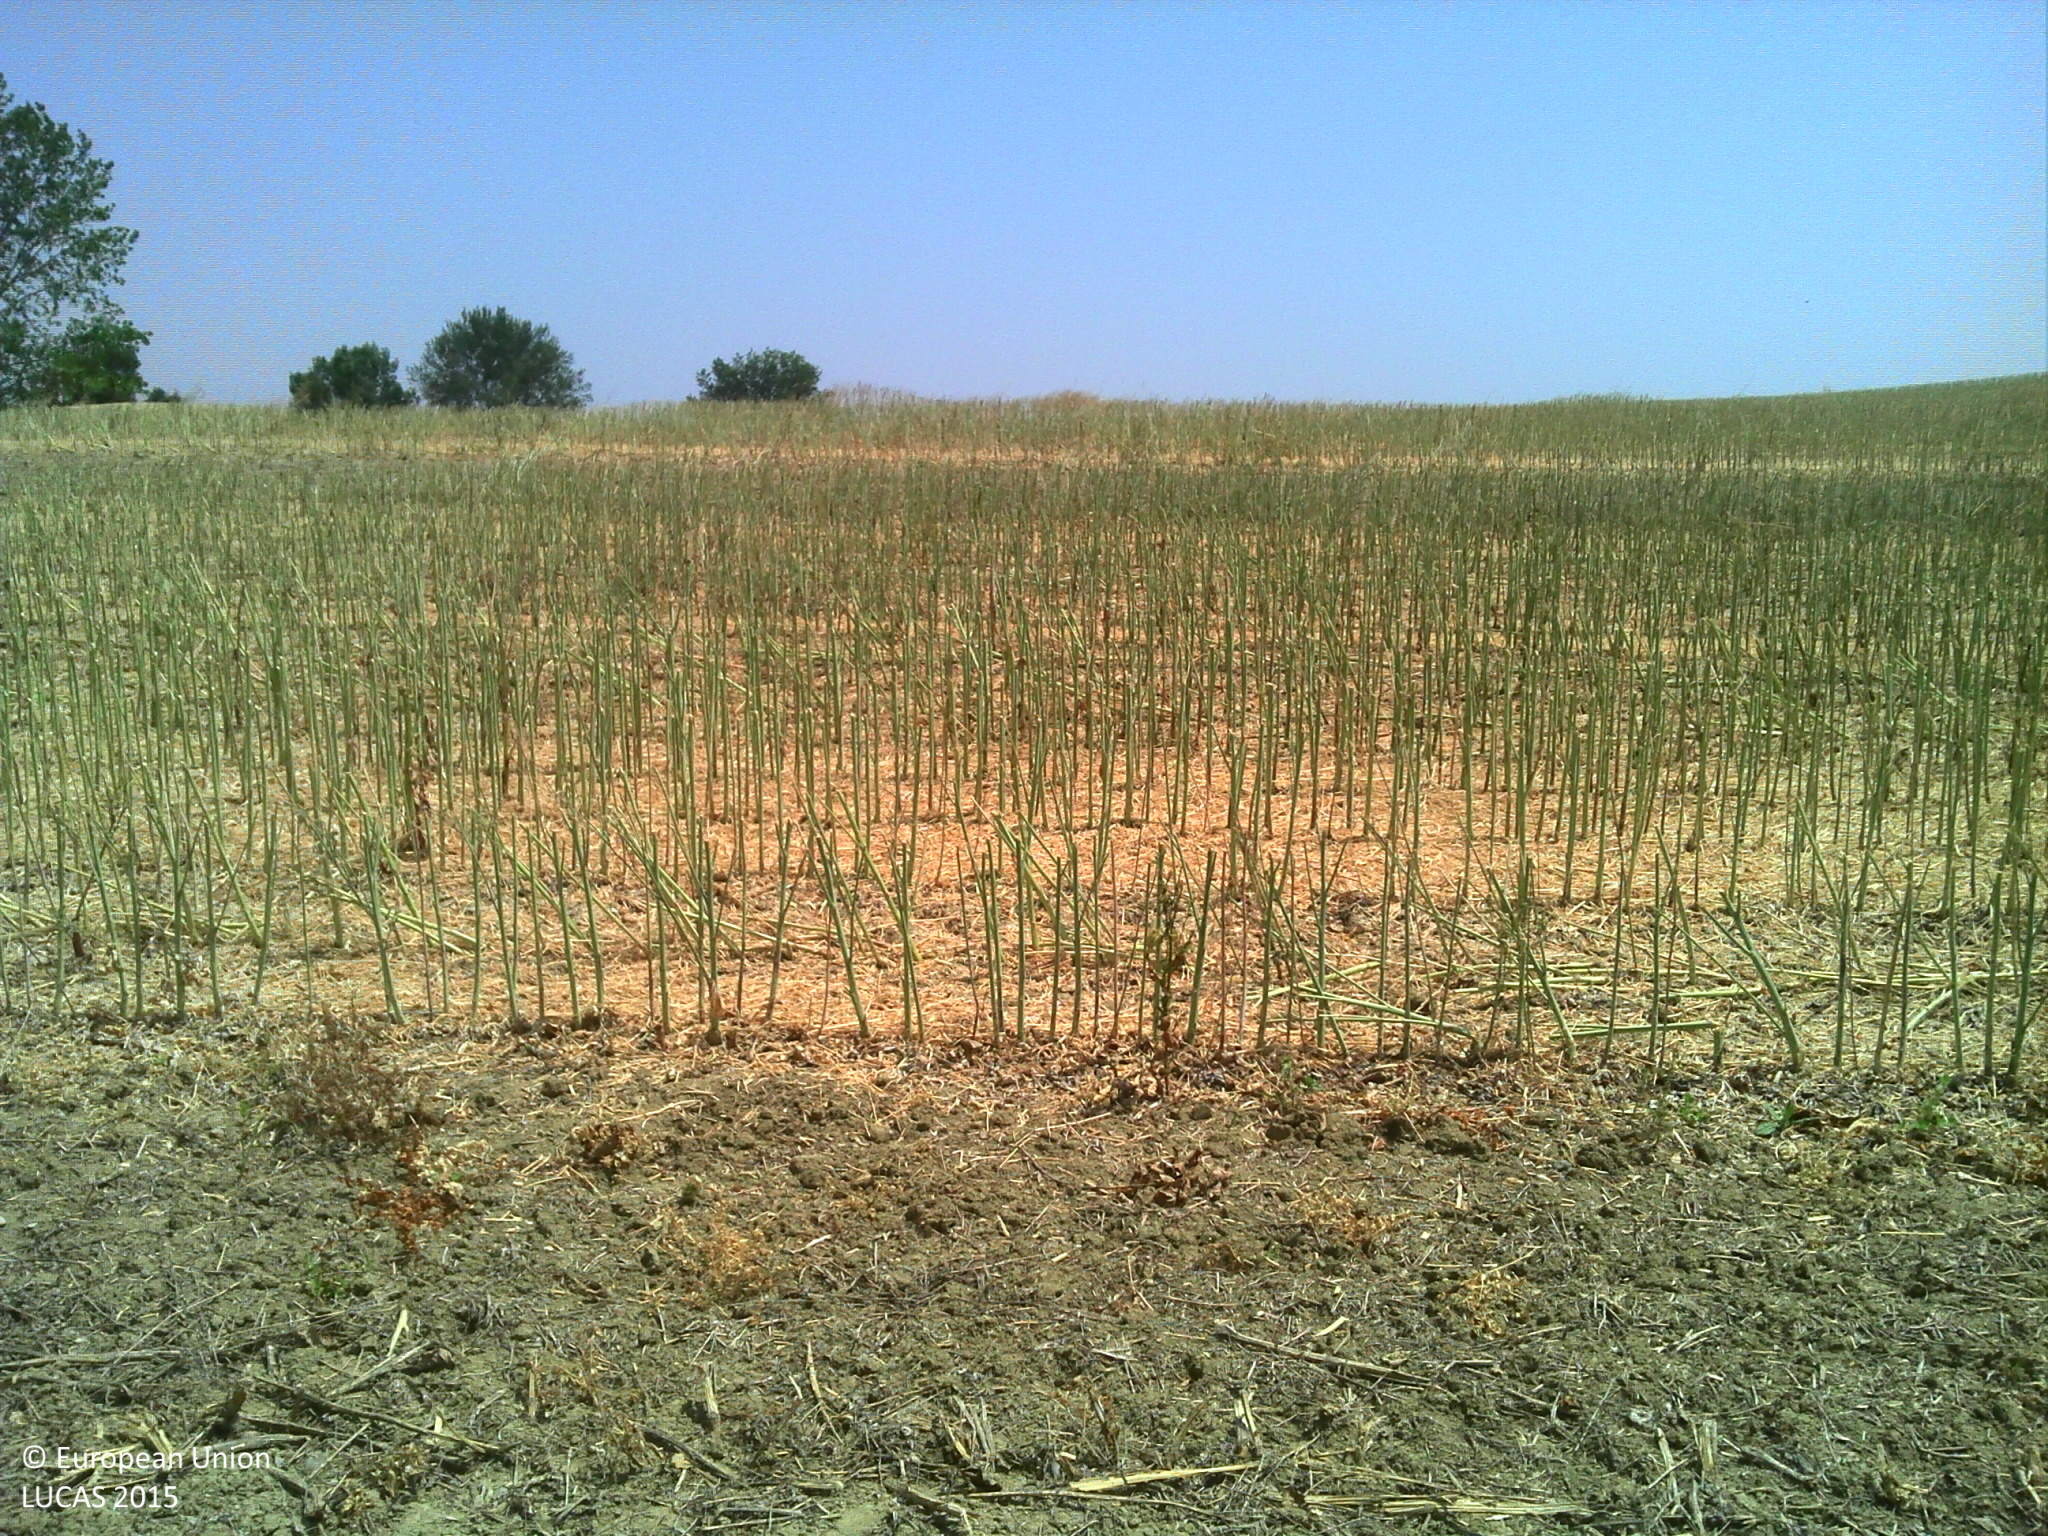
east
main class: Cropland
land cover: Rape and turnip rape
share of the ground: > 75 %
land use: Agriculture (excluding fallow land and kitchen gardens)
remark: Harvested field
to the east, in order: Rape and turnip rape; Tracks; Grass margins; Inland fresh running water; Grass margins; Lines of trees; Tracks; Durum wheat
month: July
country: FR
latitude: 43.1214
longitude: 2.0554
